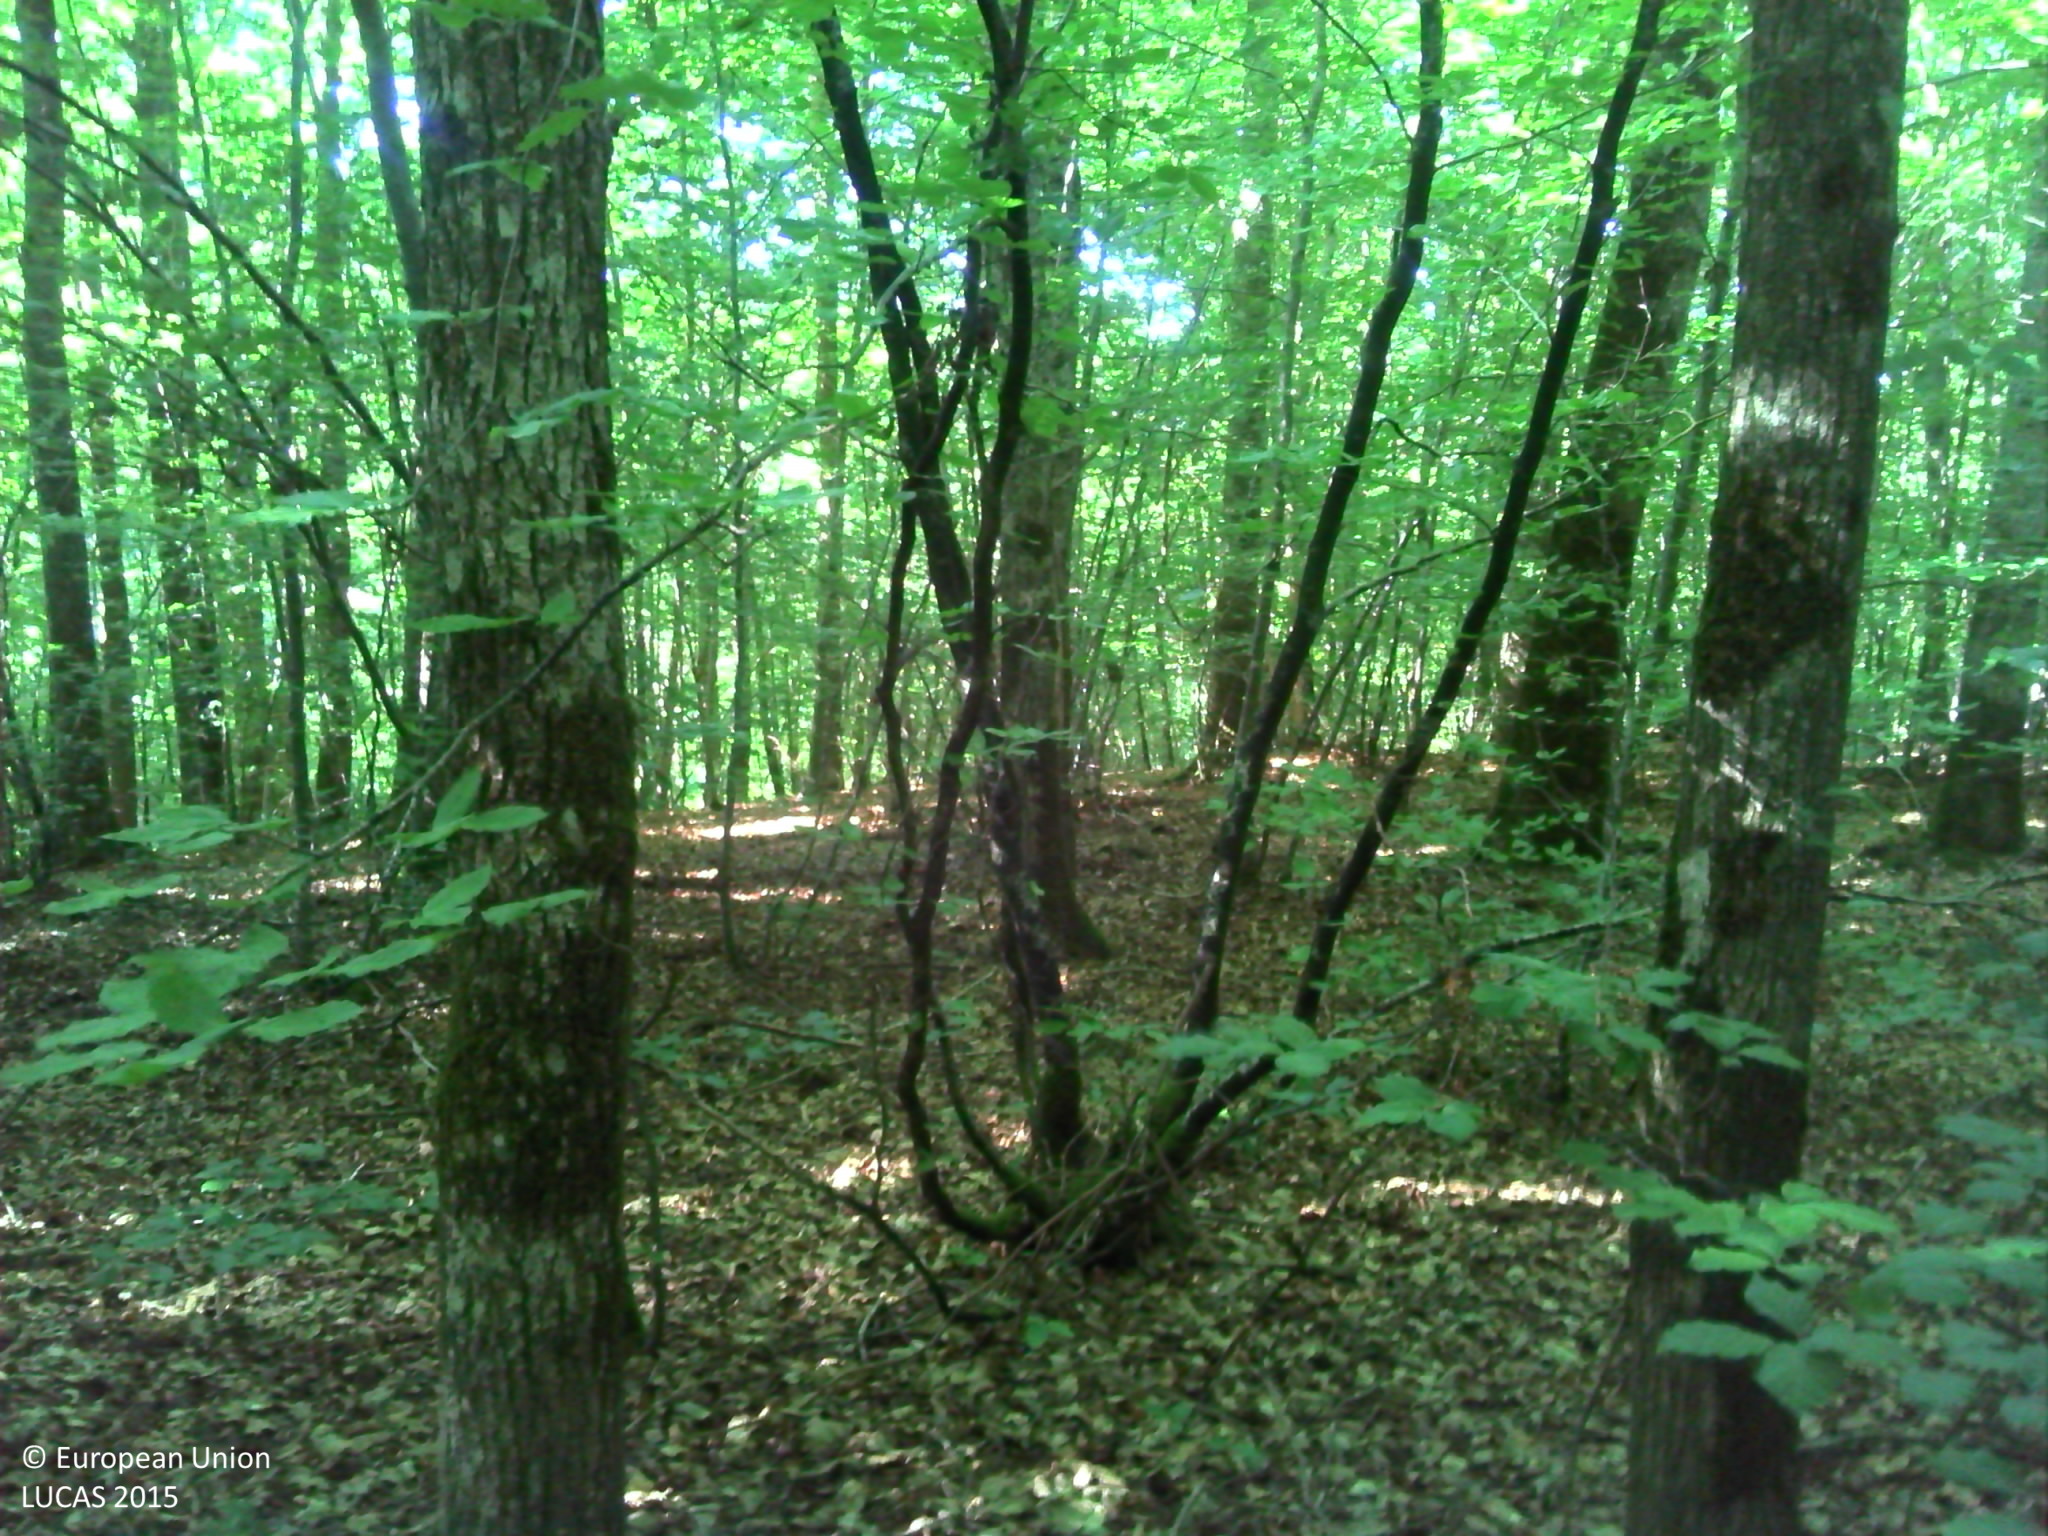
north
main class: Woodland
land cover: Broadleaved woodland
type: acidophilous oak and oak-birch forest
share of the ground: > 75 %
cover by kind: broadleaved forest trees 70 %, herbaceous plants 15 %, consolidated bare surface 15 %
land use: Forestry
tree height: > 5 m
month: July
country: FR
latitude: 49.0620
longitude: 0.7105
